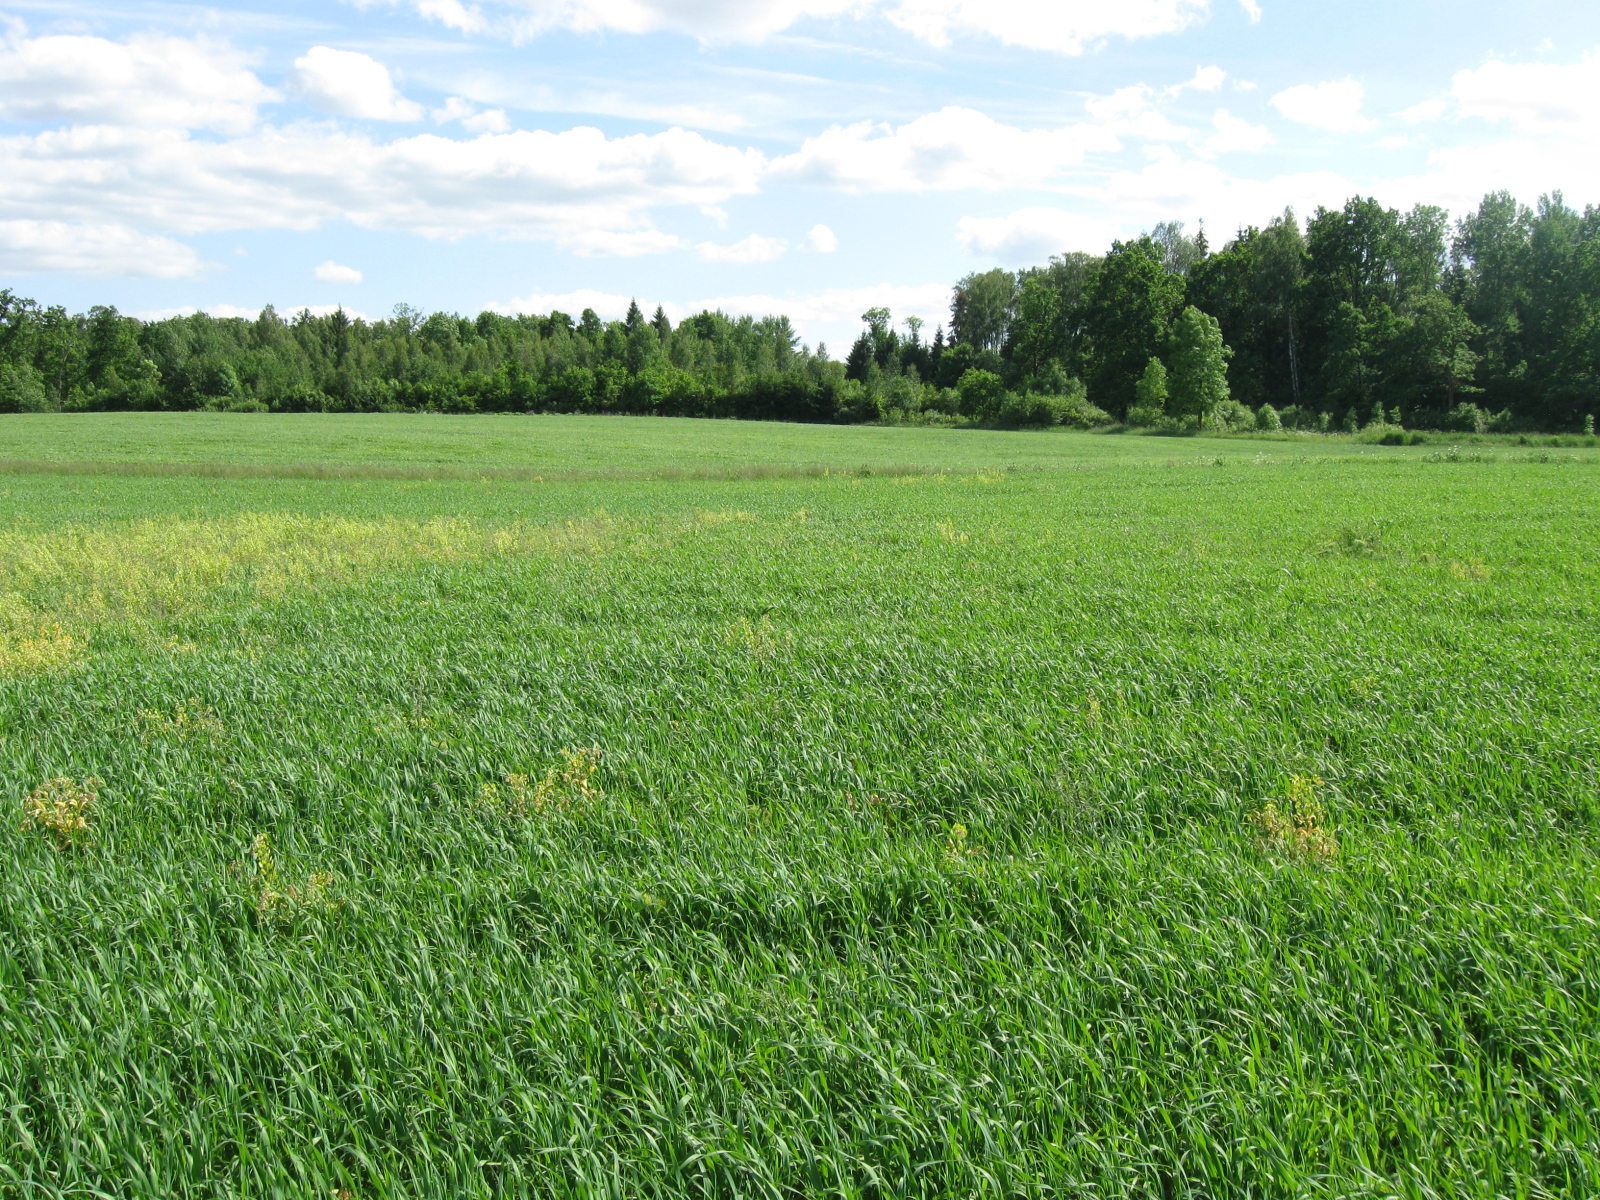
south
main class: Cropland
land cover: Oats
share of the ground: > 75 %
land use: Agriculture (excluding fallow land and kitchen gardens)
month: June
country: LT
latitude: 54.9674
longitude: 23.7535
